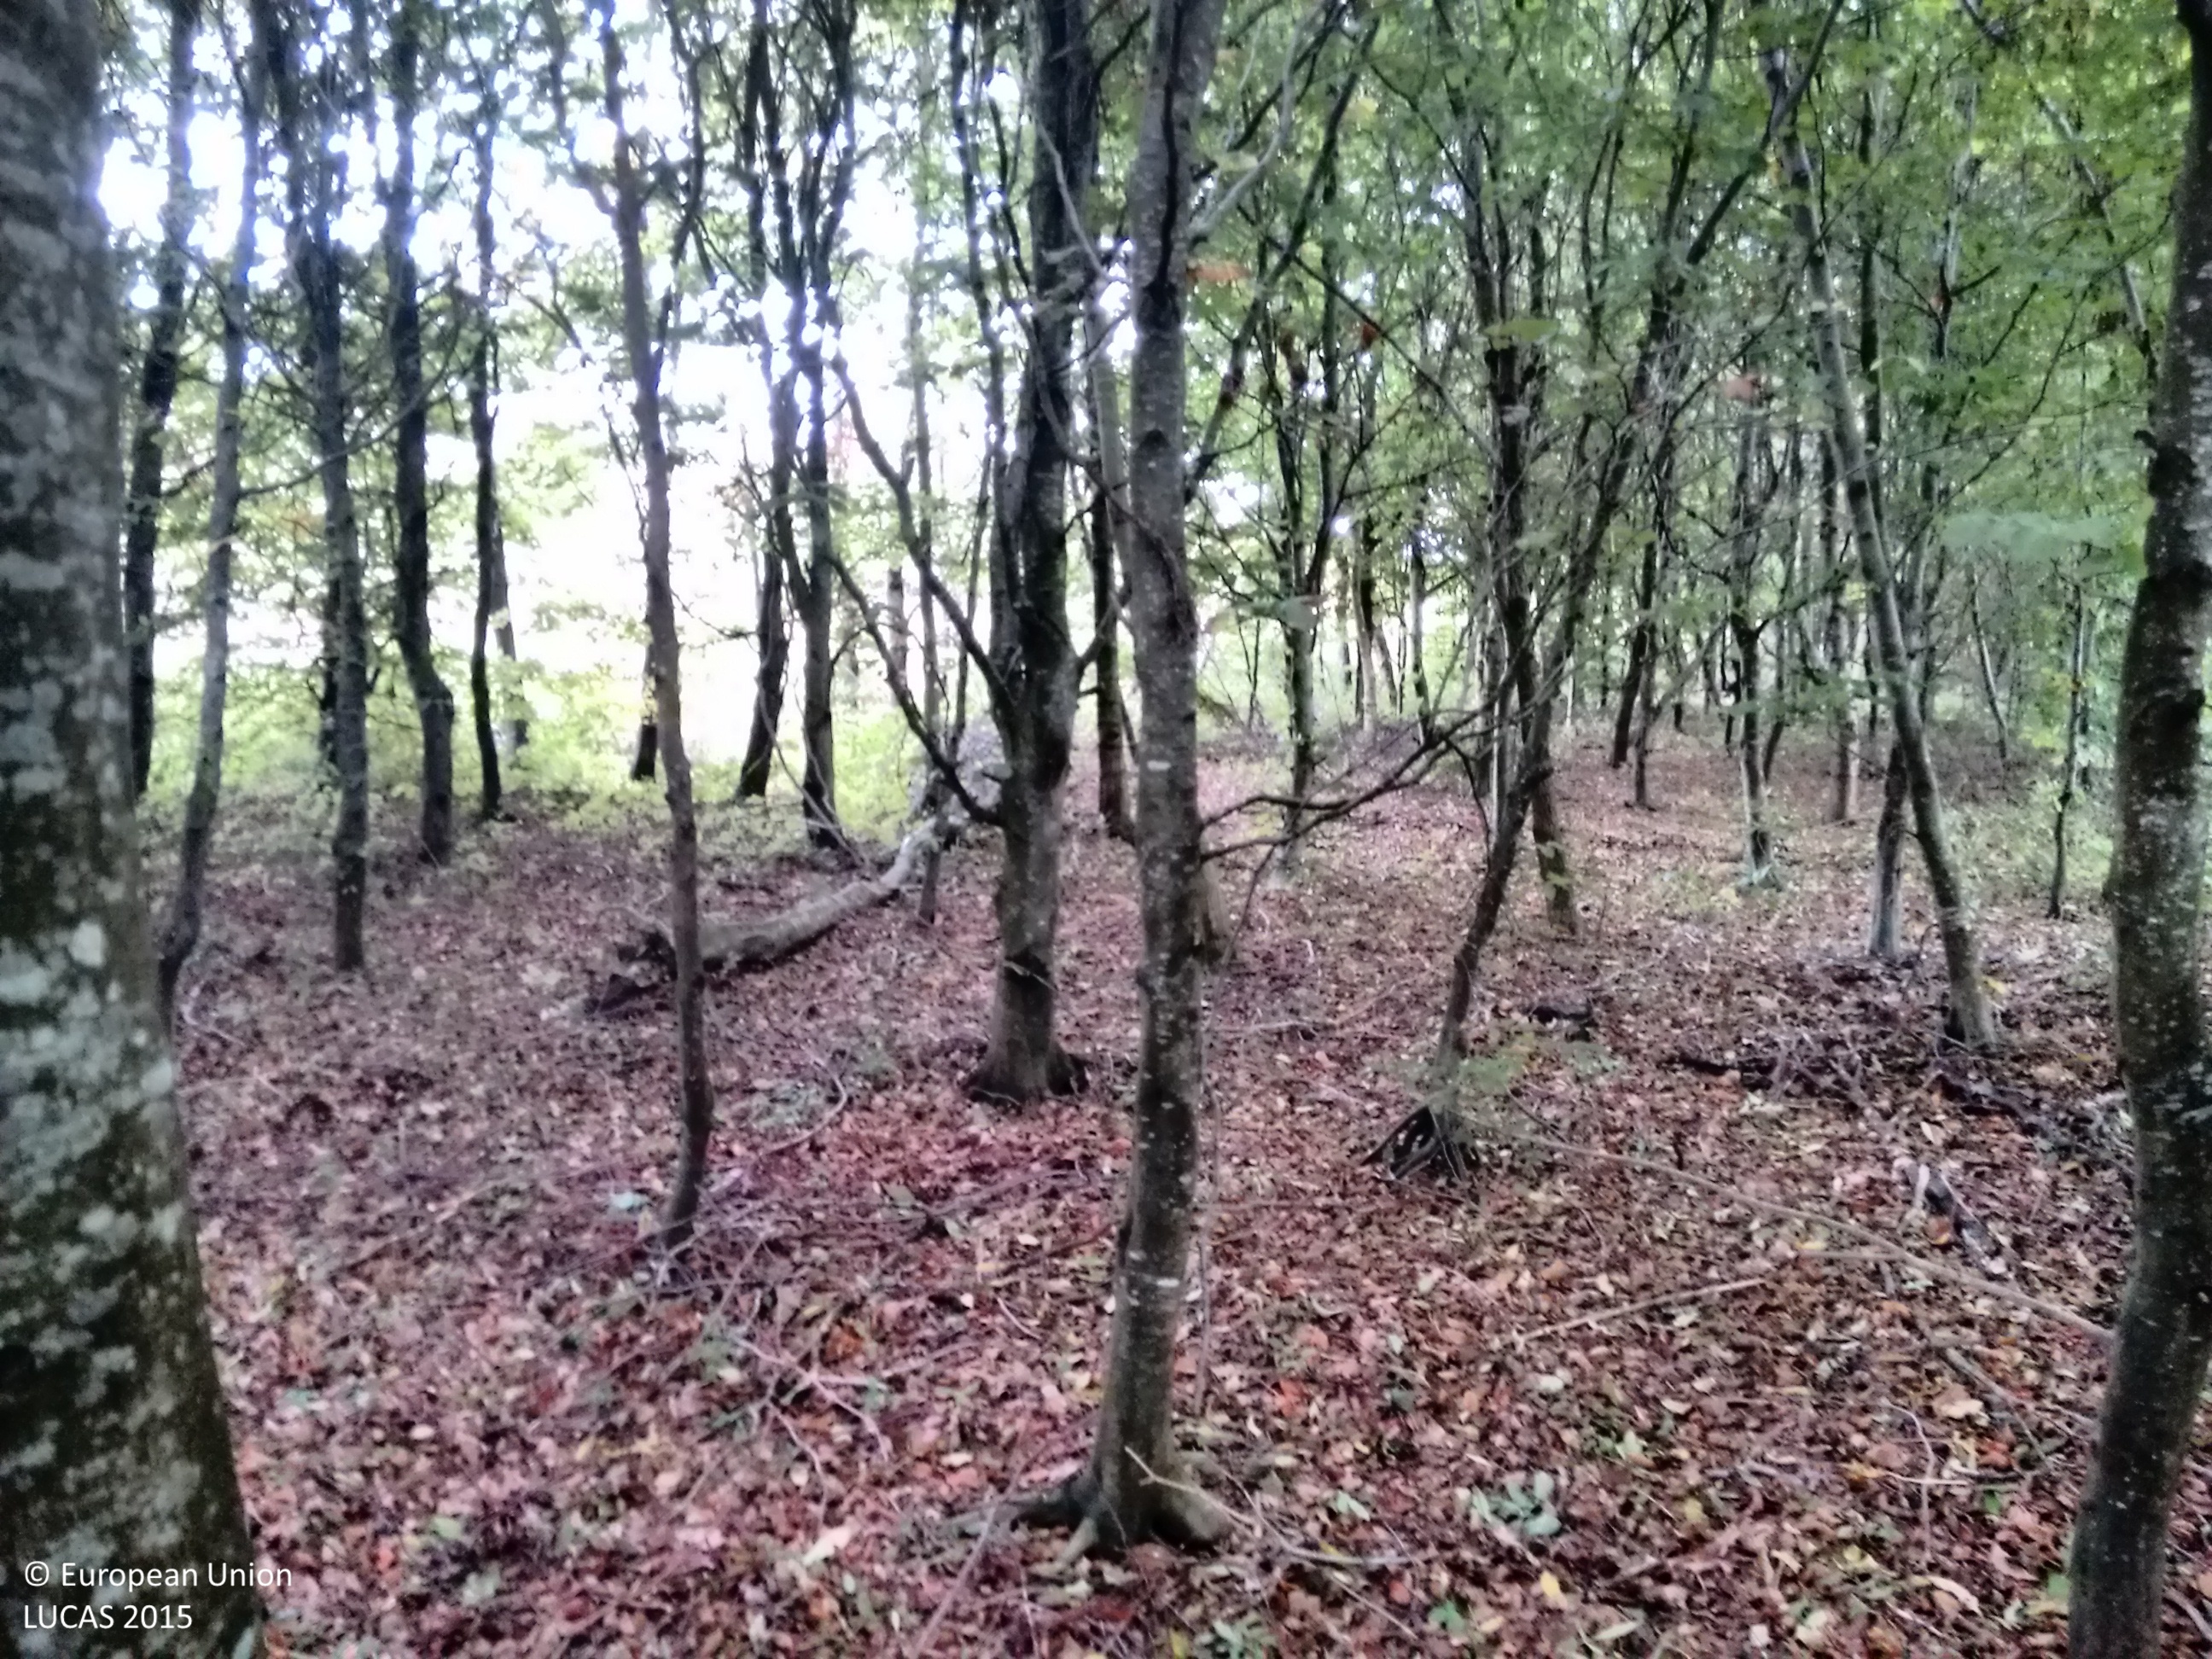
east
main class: Woodland
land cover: Broadleaved woodland
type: mesophytic deciduous forest
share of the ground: > 75 %
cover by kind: broadleaved forest trees 100 %
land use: Forestry
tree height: > 5 m
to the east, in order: Broadleaved woodland; Shrubland with sparse tree cover; Electric lines; Broadleaved woodland; Shruby margins
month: October
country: IE
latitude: 53.1033
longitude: -7.7778
